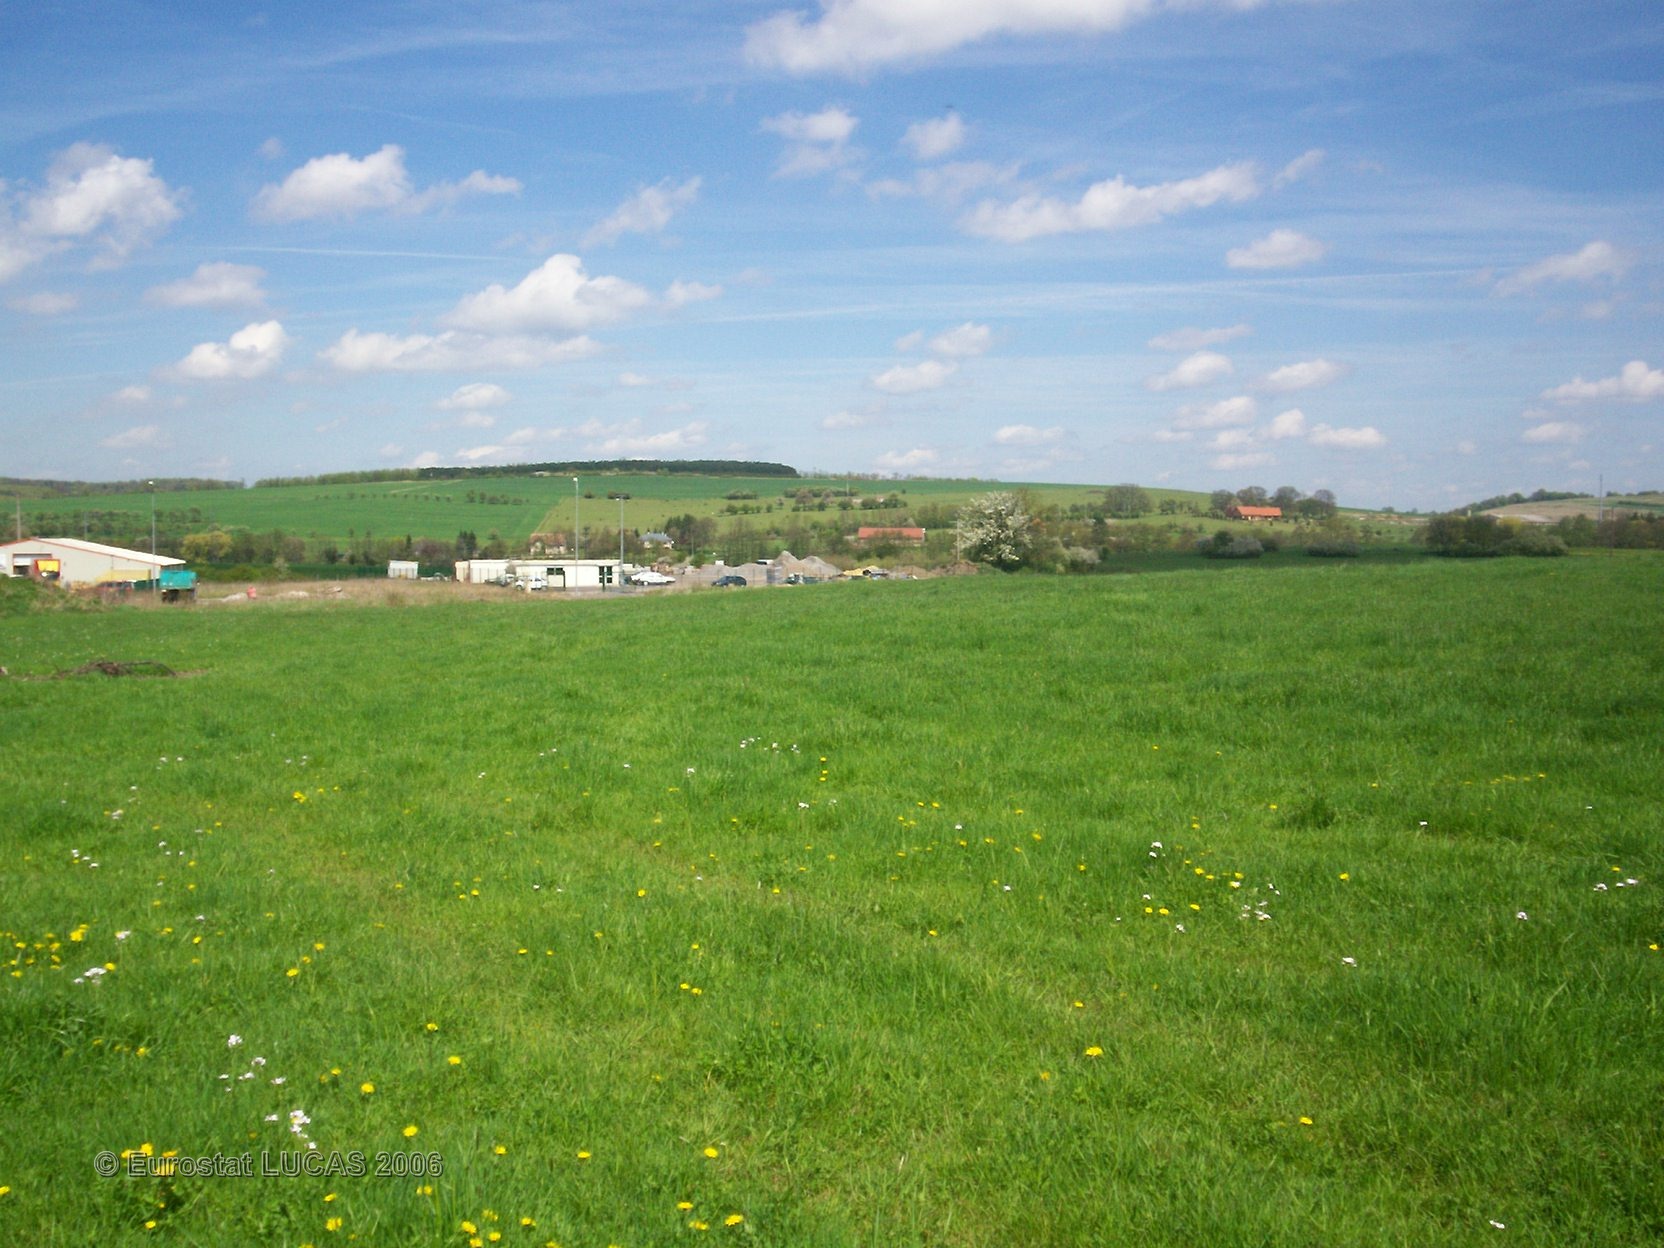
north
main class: Grassland
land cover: Grassland without tree/shrub cover
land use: Agriculture (excluding fallow land and kitchen gardens)
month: May
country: FR
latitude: 49.0941
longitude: 6.7546
